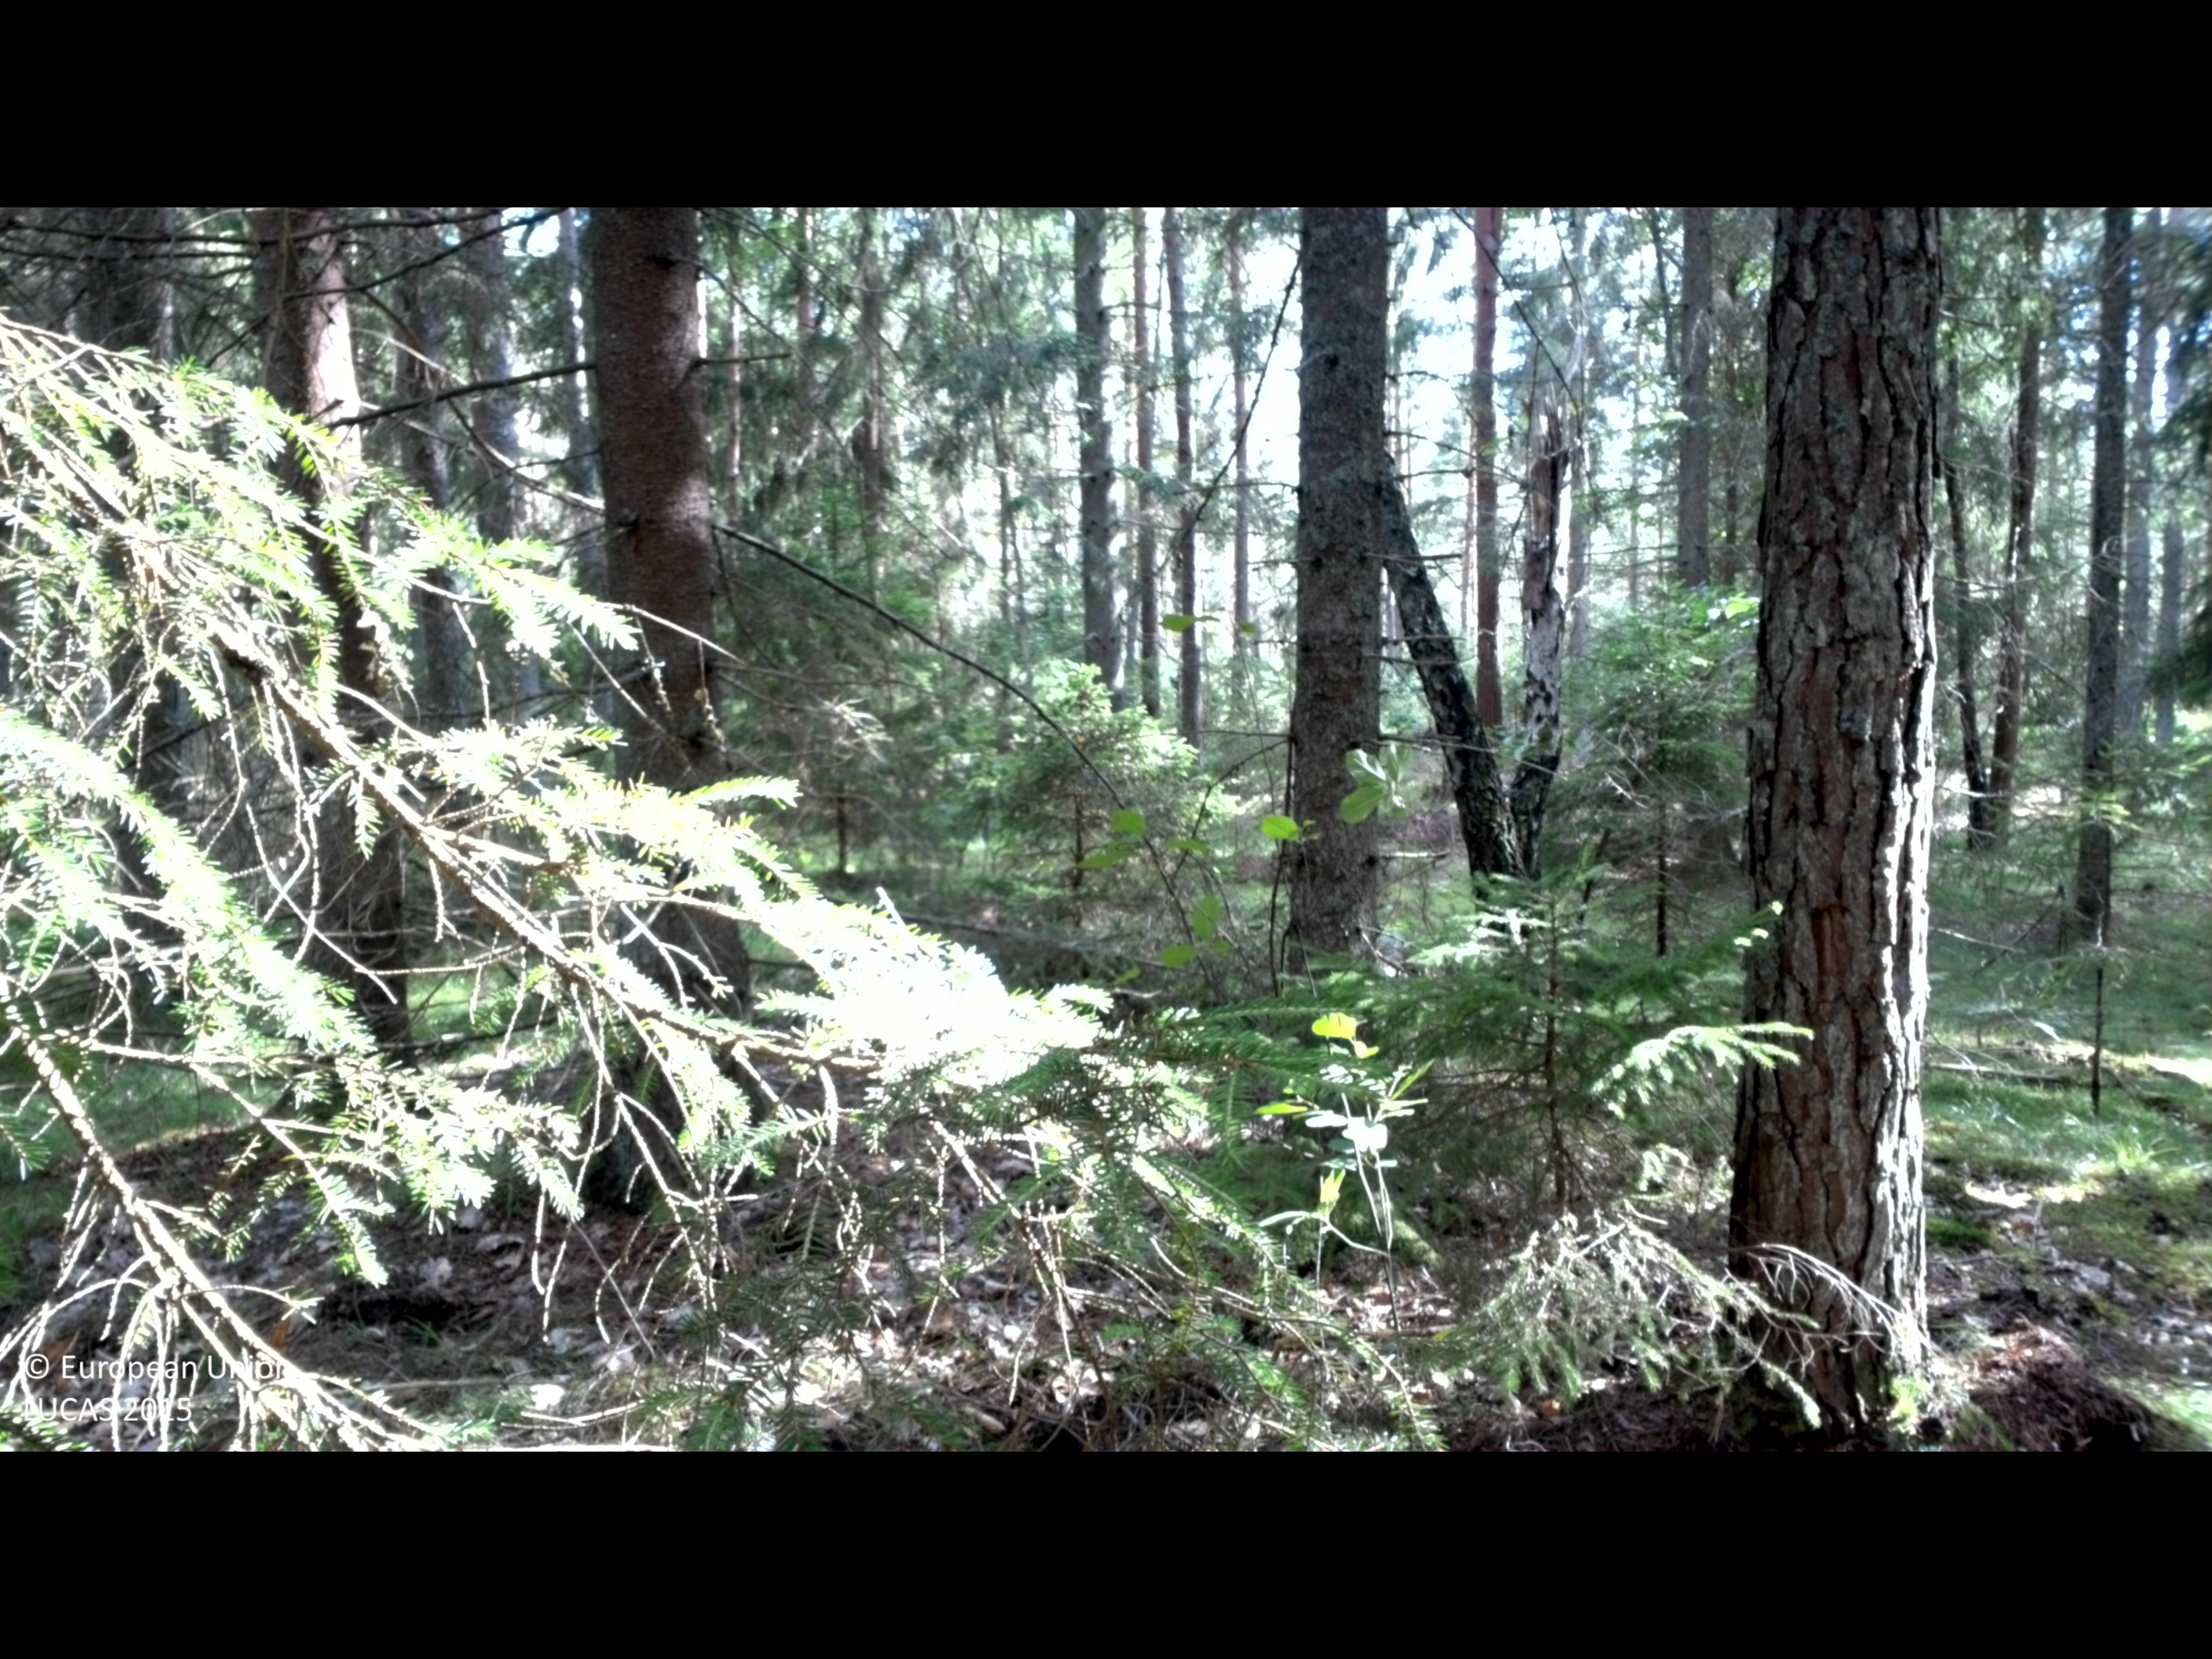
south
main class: Woodland
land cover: Spruce dominated coniferous woodland
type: boreal forest
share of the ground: > 75 %
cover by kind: coniferous forest trees 75 %, lichens and mosses 20 %, herbaceous plants 5 %
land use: Forestry
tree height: > 5 m
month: July
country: SE
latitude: 56.4397
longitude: 14.8152
